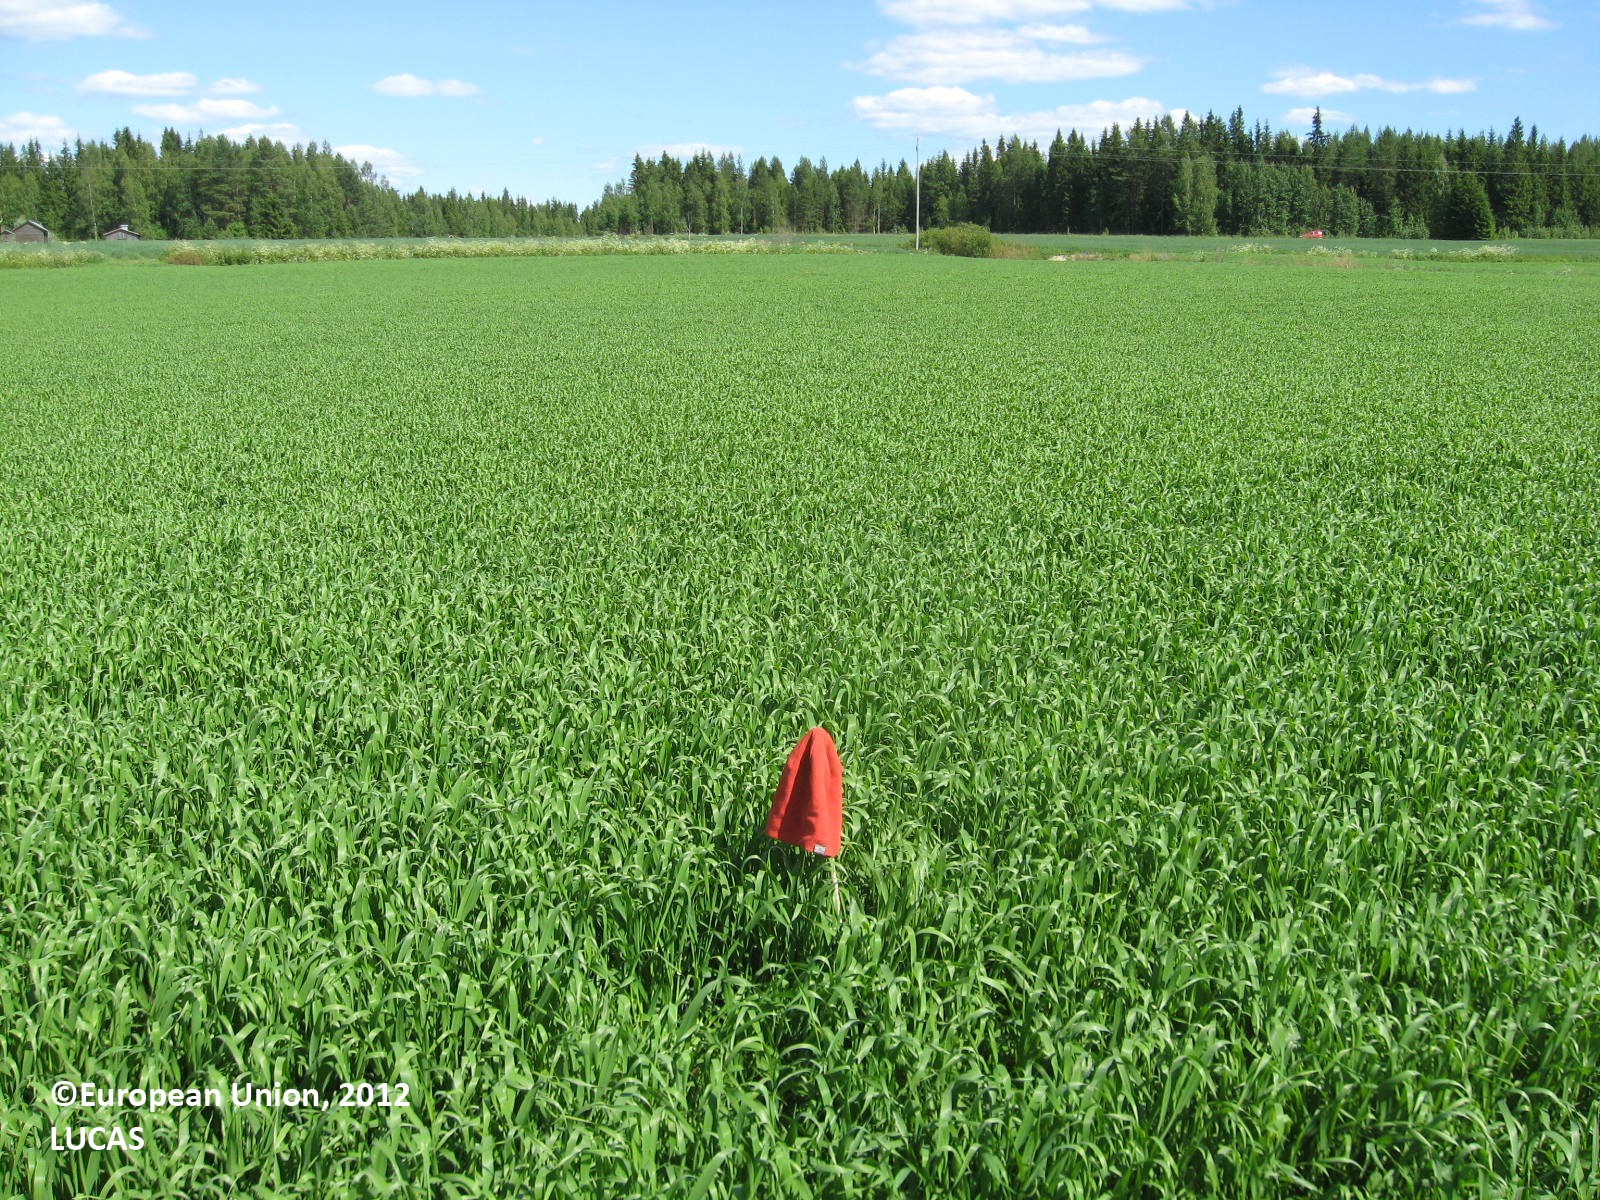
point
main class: Cropland
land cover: Barley
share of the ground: > 75 %
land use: Agriculture (excluding fallow land and kitchen gardens)
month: July
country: FI
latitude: 62.5401
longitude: 22.7919
